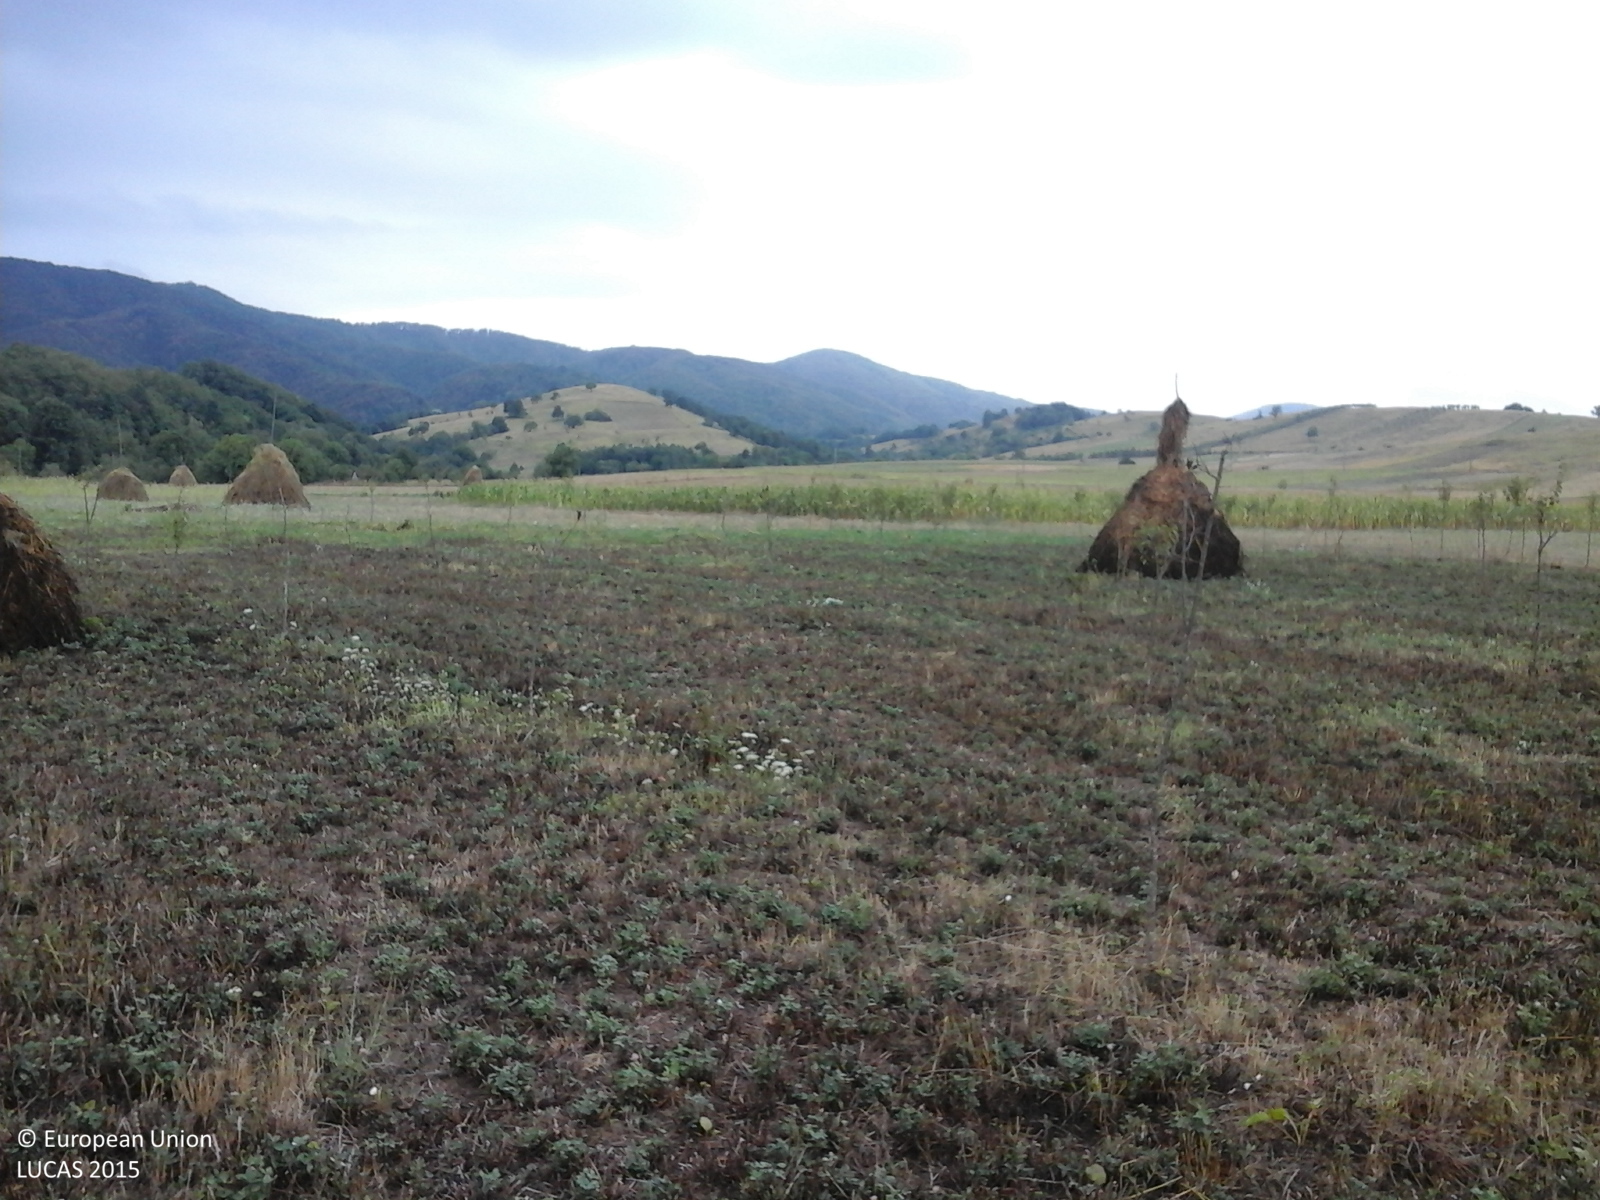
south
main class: Cropland
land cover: Apple fruit
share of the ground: > 75 %
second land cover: Lucerne
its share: > 75 %
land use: Agriculture (excluding fallow land and kitchen gardens)
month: August
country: RO
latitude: 44.8603
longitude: 21.9421
